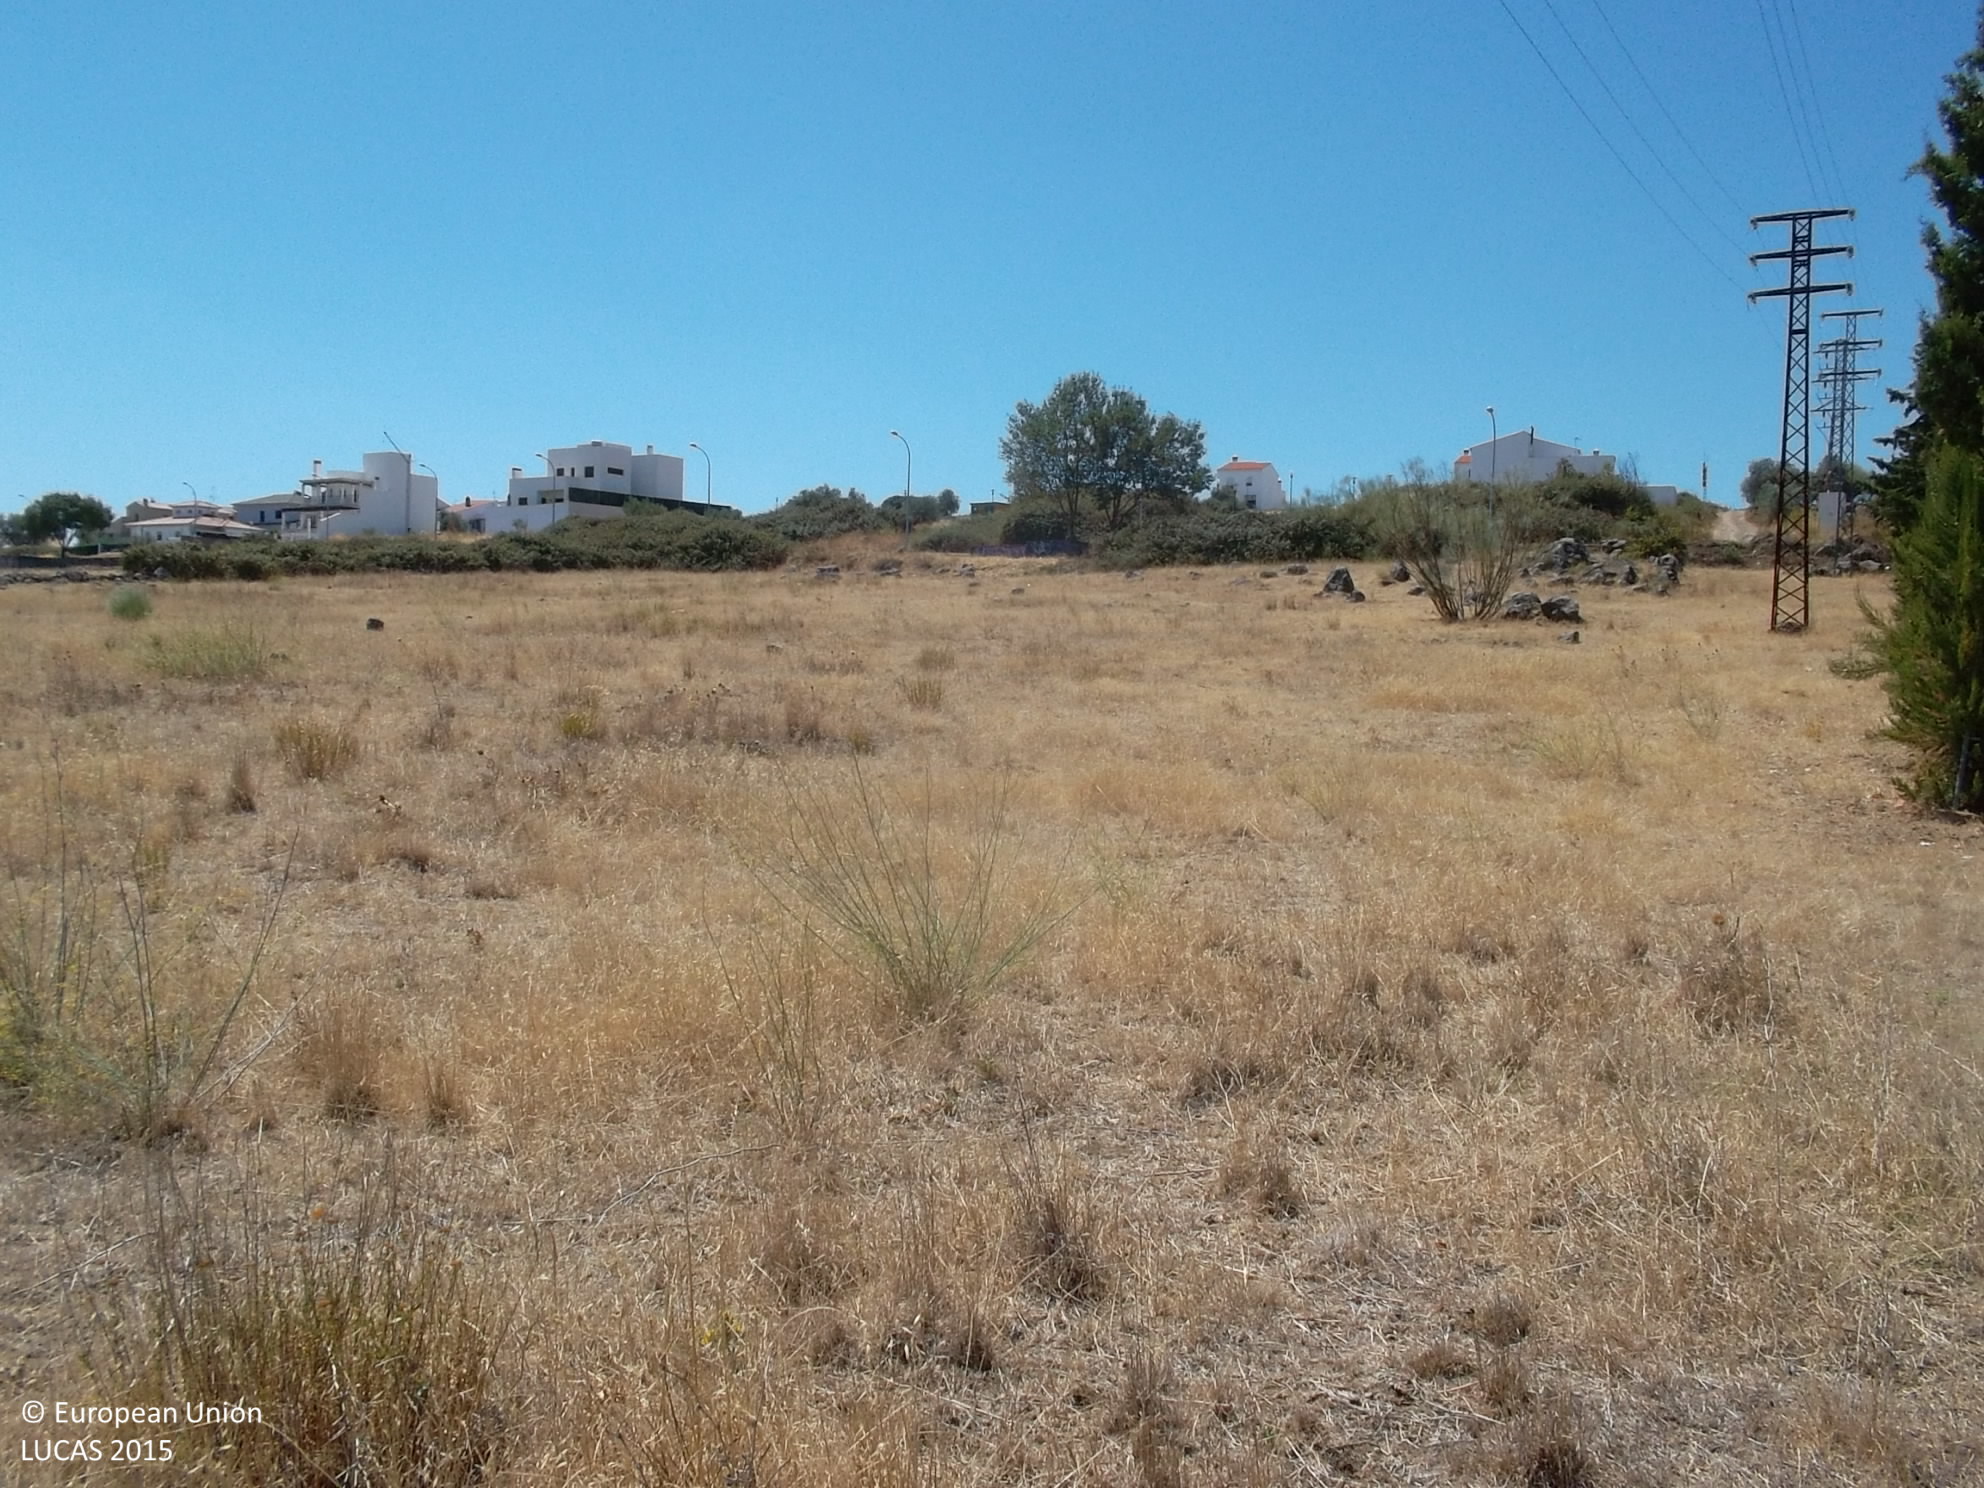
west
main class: Grassland
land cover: Spontaneously vegetated surfaces
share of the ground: > 75 %
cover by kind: herbaceous plants 100 %
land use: Fallow land
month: August
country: ES
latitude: 38.1681
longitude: -6.6579
